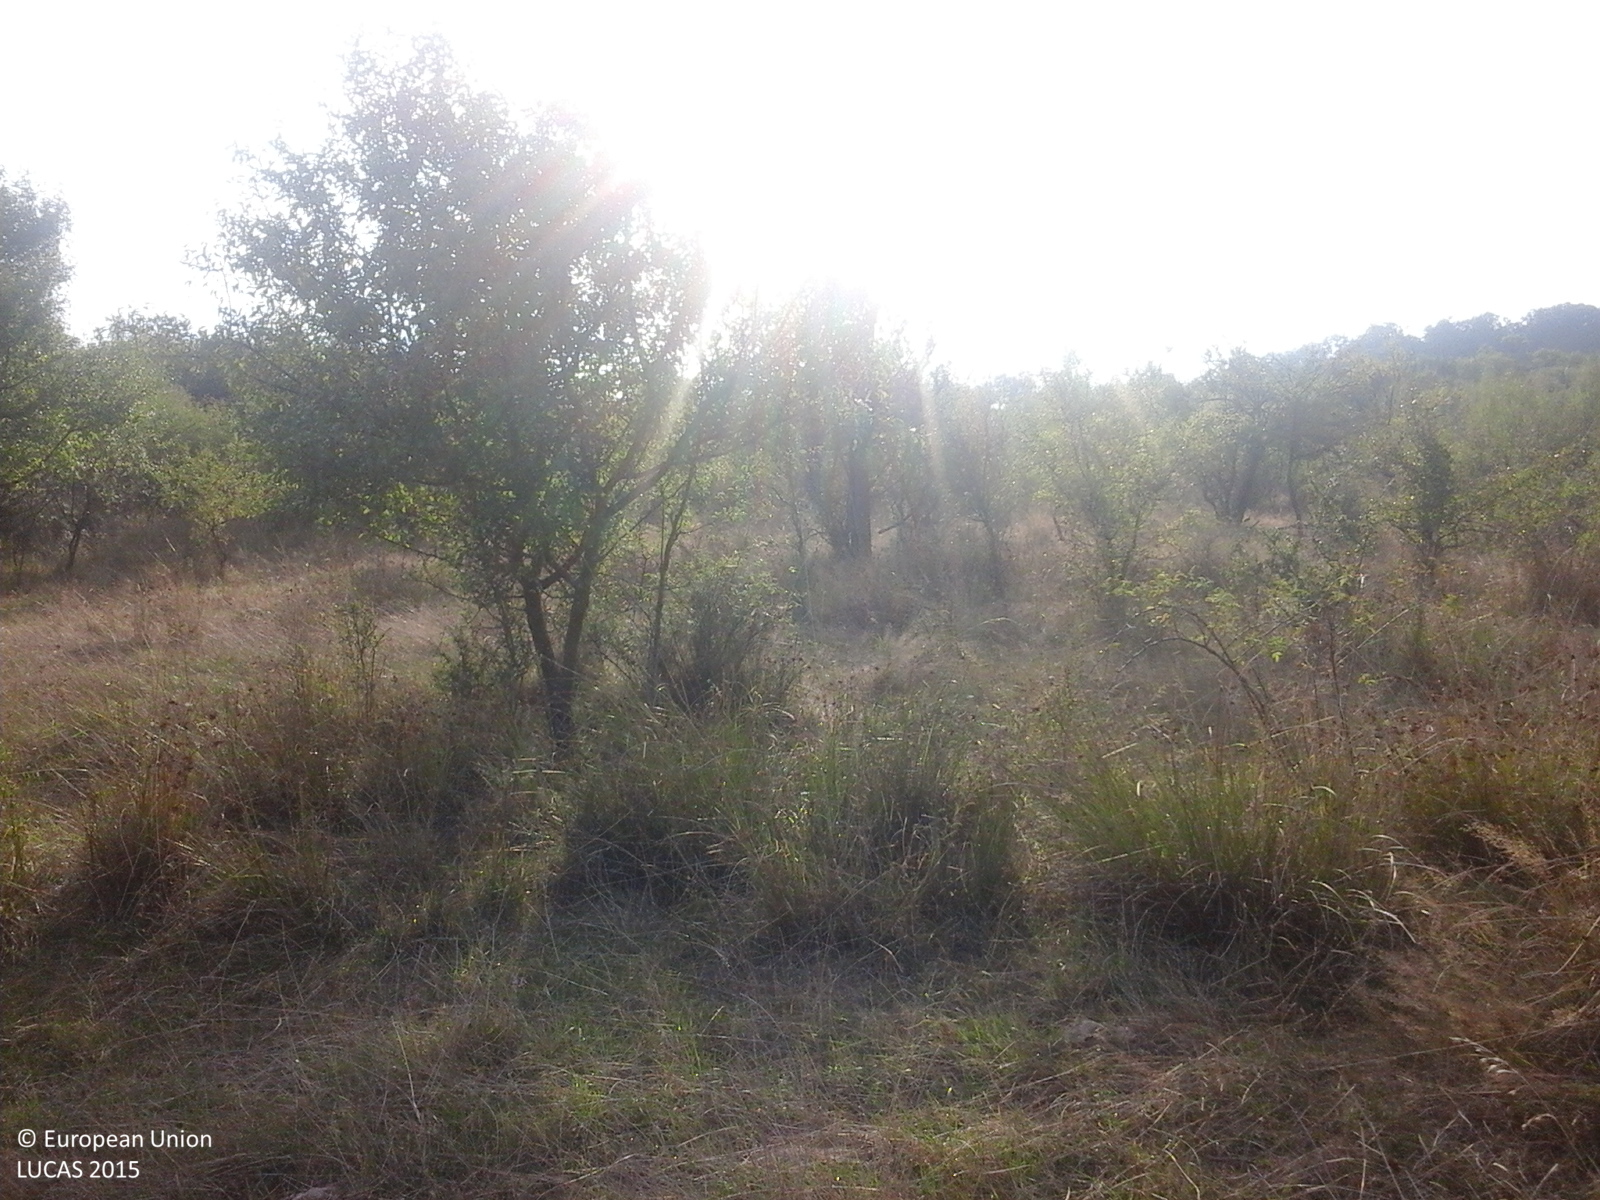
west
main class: Grassland
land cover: Grassland with sparse tree/shrub cover
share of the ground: > 75 %
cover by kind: herbaceous plants 85 %, shrubs 10 %, broadleaved forest trees 5 %
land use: Agriculture (excluding fallow land and kitchen gardens)
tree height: < 5 m
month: August
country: RO
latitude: 46.4958
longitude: 21.9656
